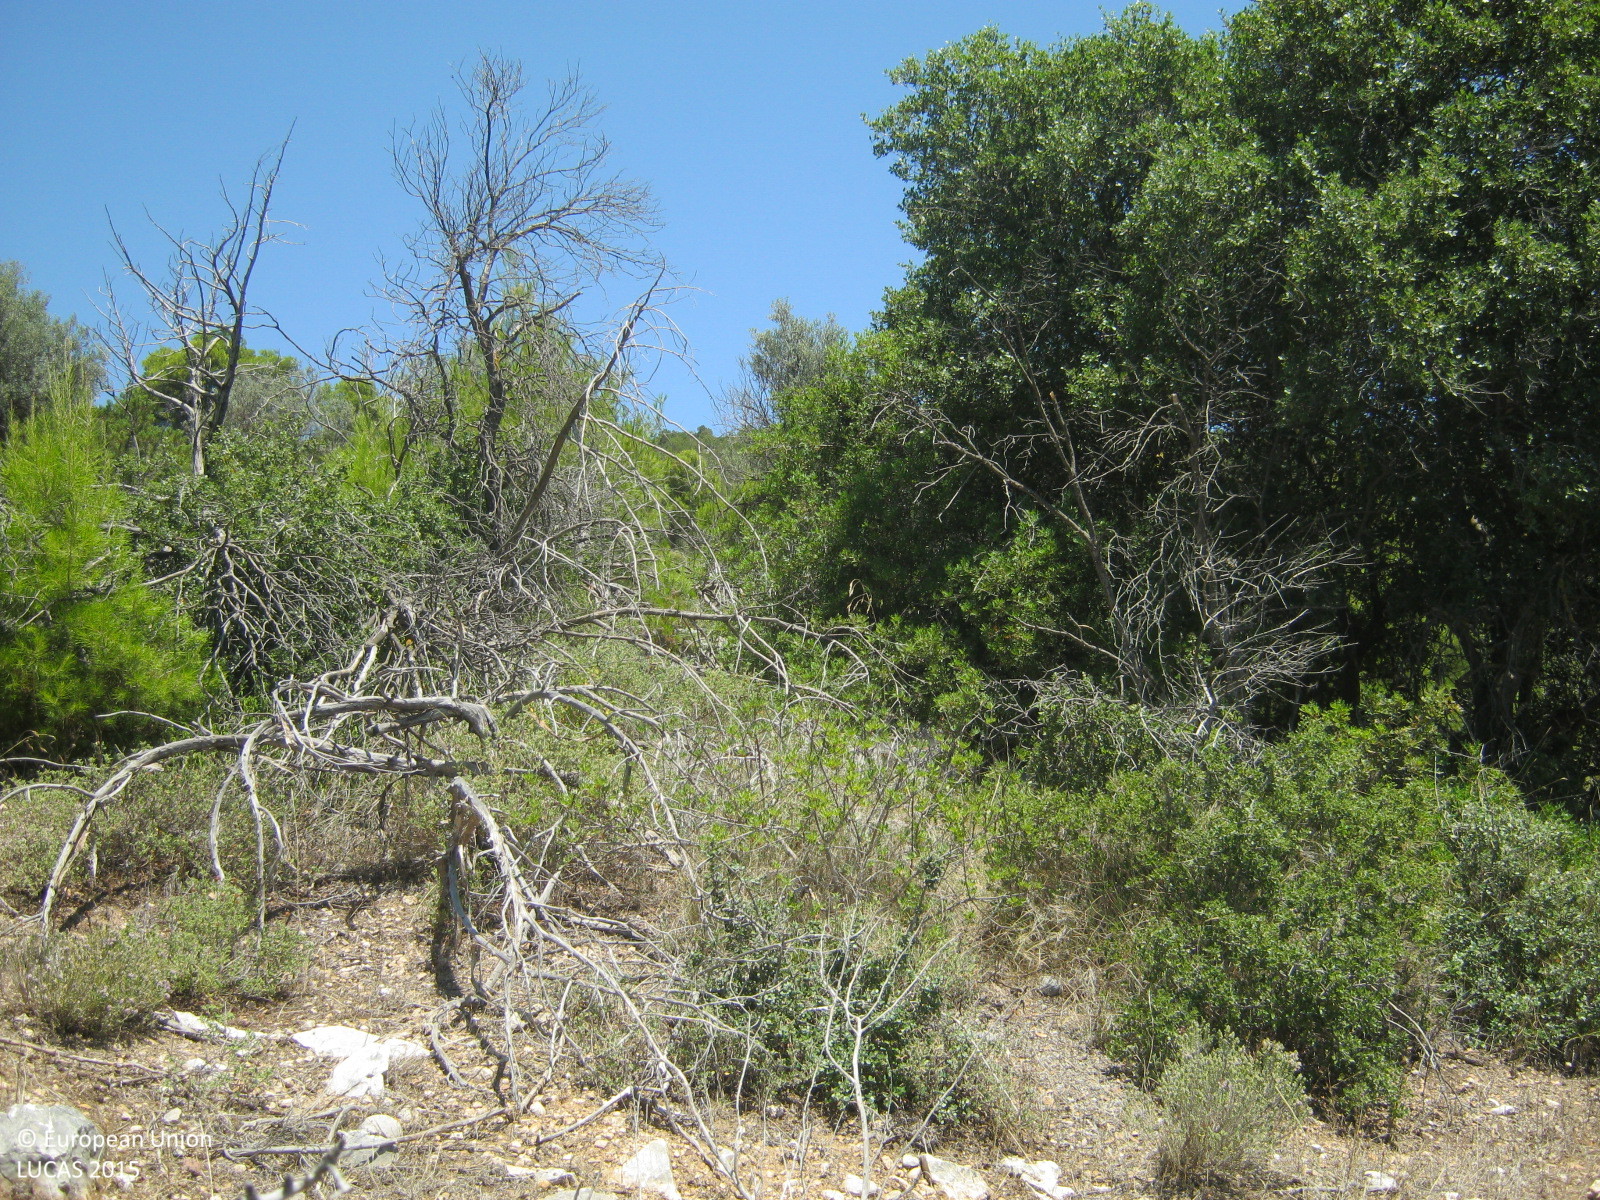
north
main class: Shrubland
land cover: Shrubland with sparse tree cover
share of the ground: 50 - 75 %
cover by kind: shrubs 55 %, unconsolidated bare surface 30 %, herbaceous plants 10 %, coniferous forest trees 5 %
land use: Agriculture (excluding fallow land and kitchen gardens)
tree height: < 5 m
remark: Burnt area
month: July
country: GR
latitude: 37.8412
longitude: 22.8678
